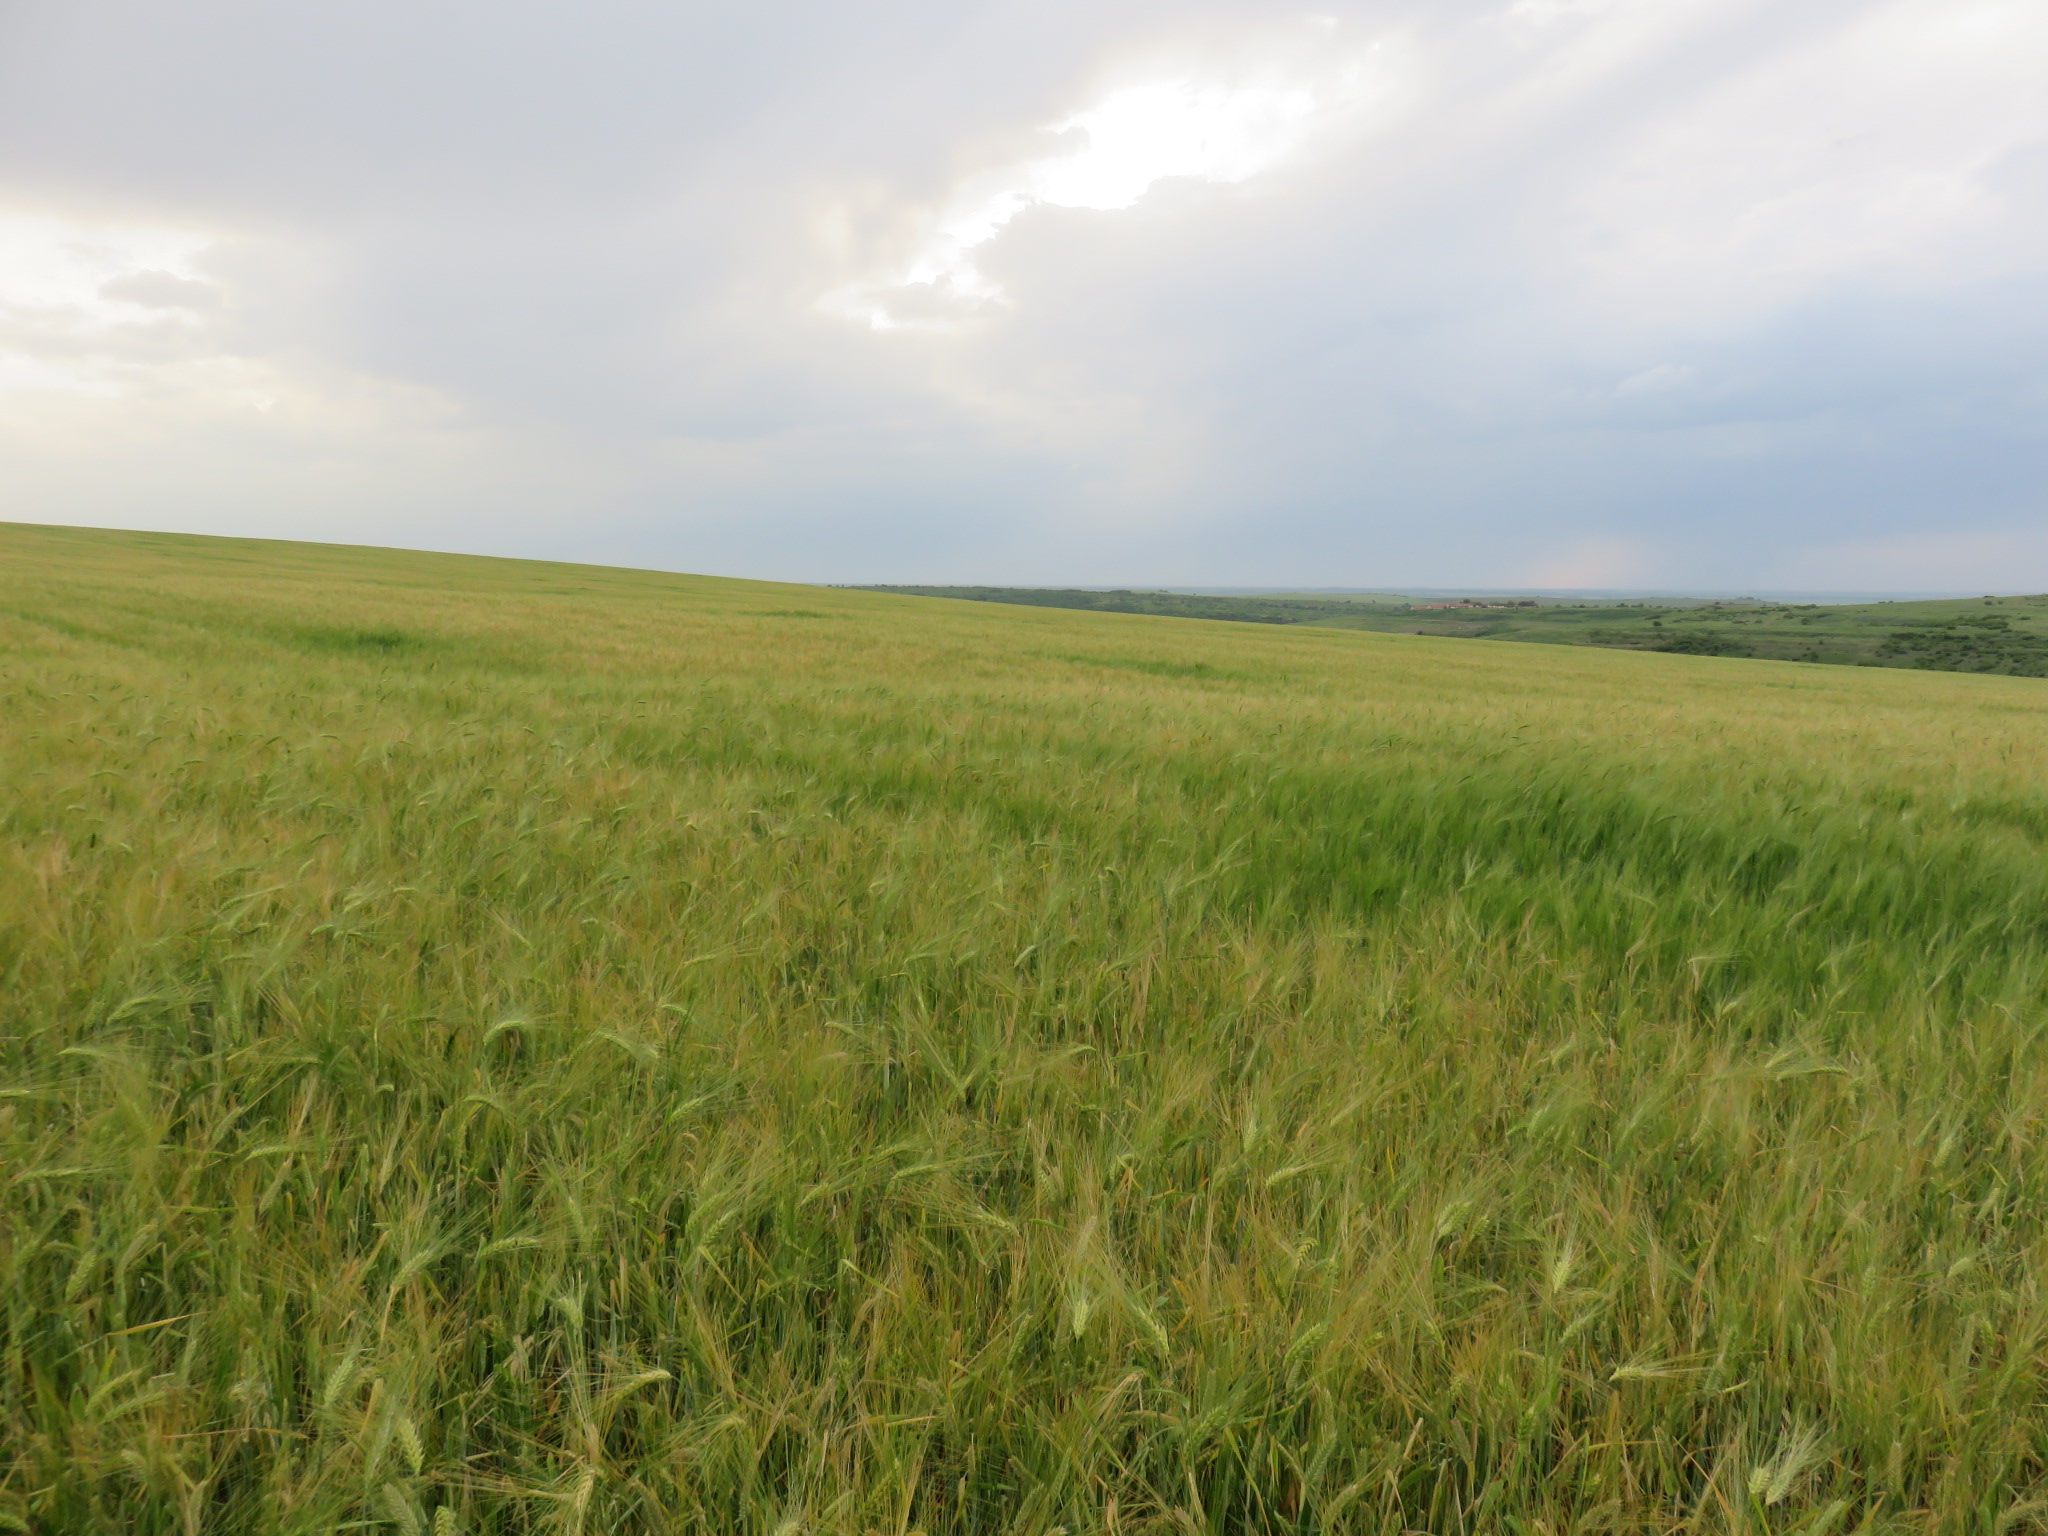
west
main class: Cropland
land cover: Barley
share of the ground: > 75 %
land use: Agriculture (excluding fallow land and kitchen gardens)
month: May
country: BG
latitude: 43.3080
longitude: 24.4963
